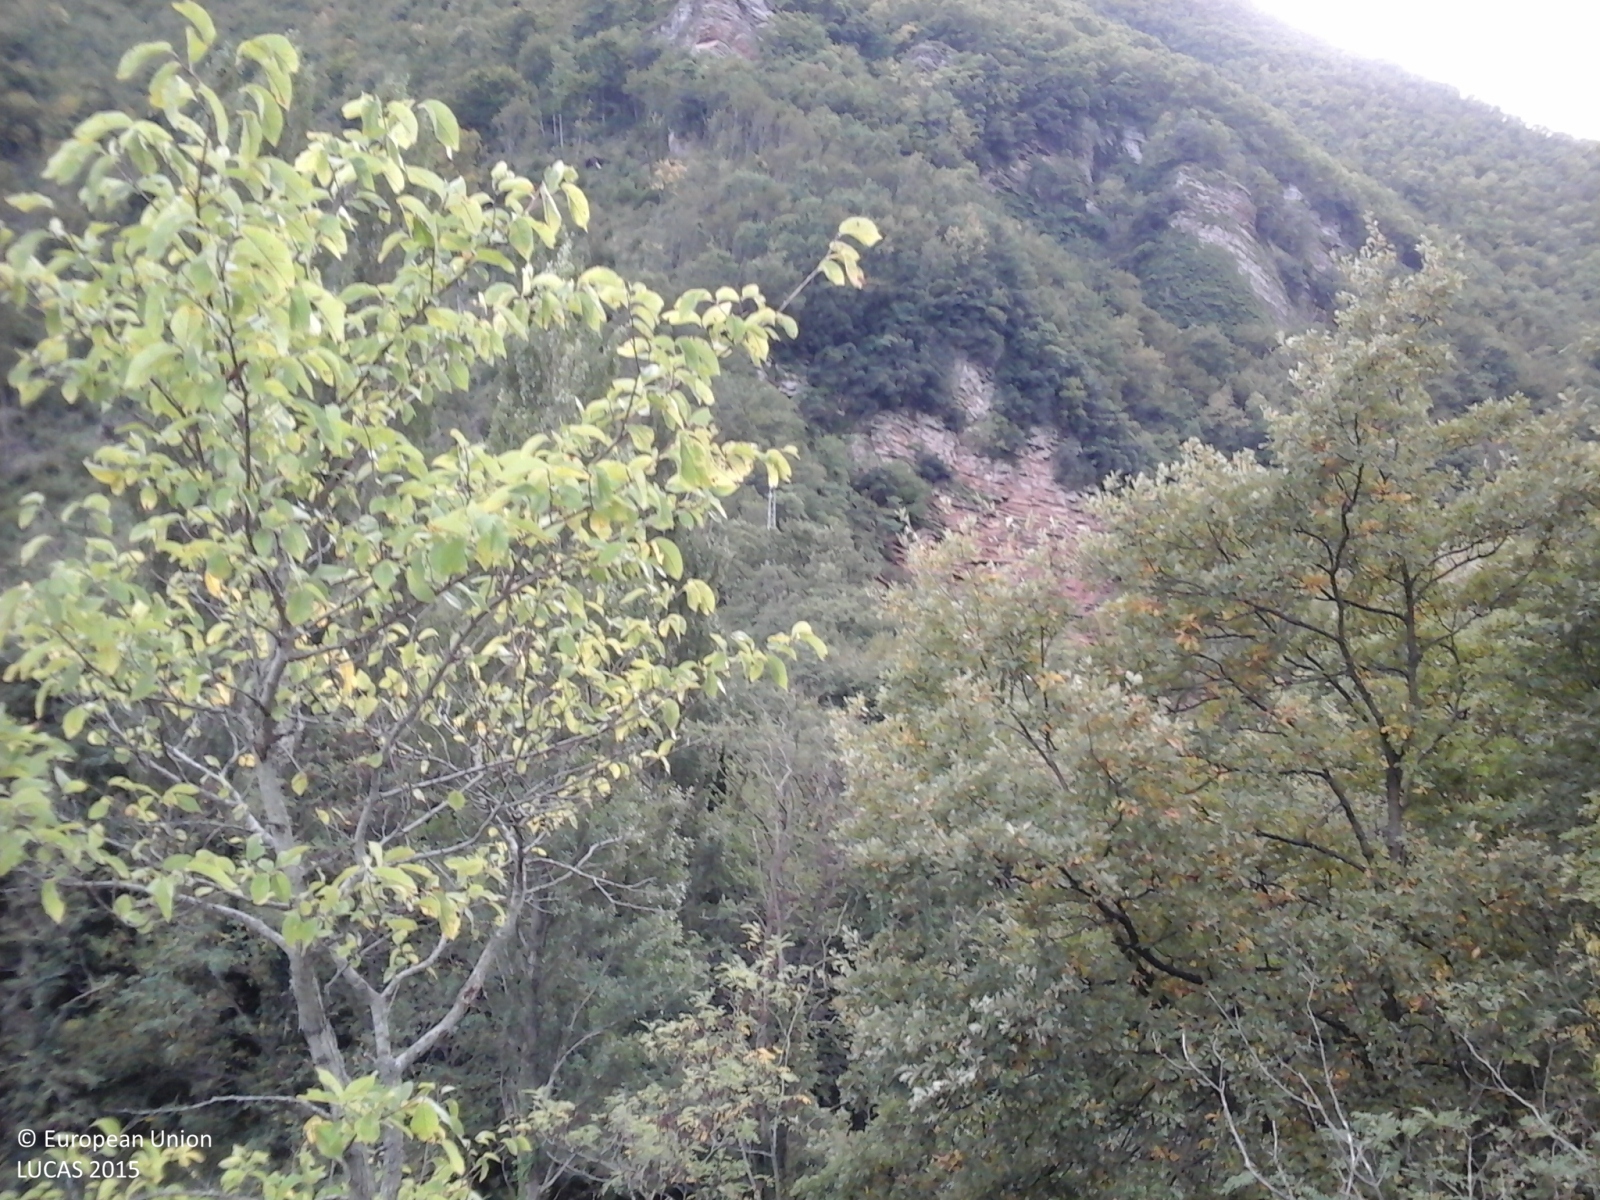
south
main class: Woodland
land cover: Broadleaved woodland
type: thermophilous deciduous forest
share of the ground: > 75 %
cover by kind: broadleaved forest trees 100 %
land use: Forestry
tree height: > 5 m
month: October
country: IT
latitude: 43.5243
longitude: 12.5791
